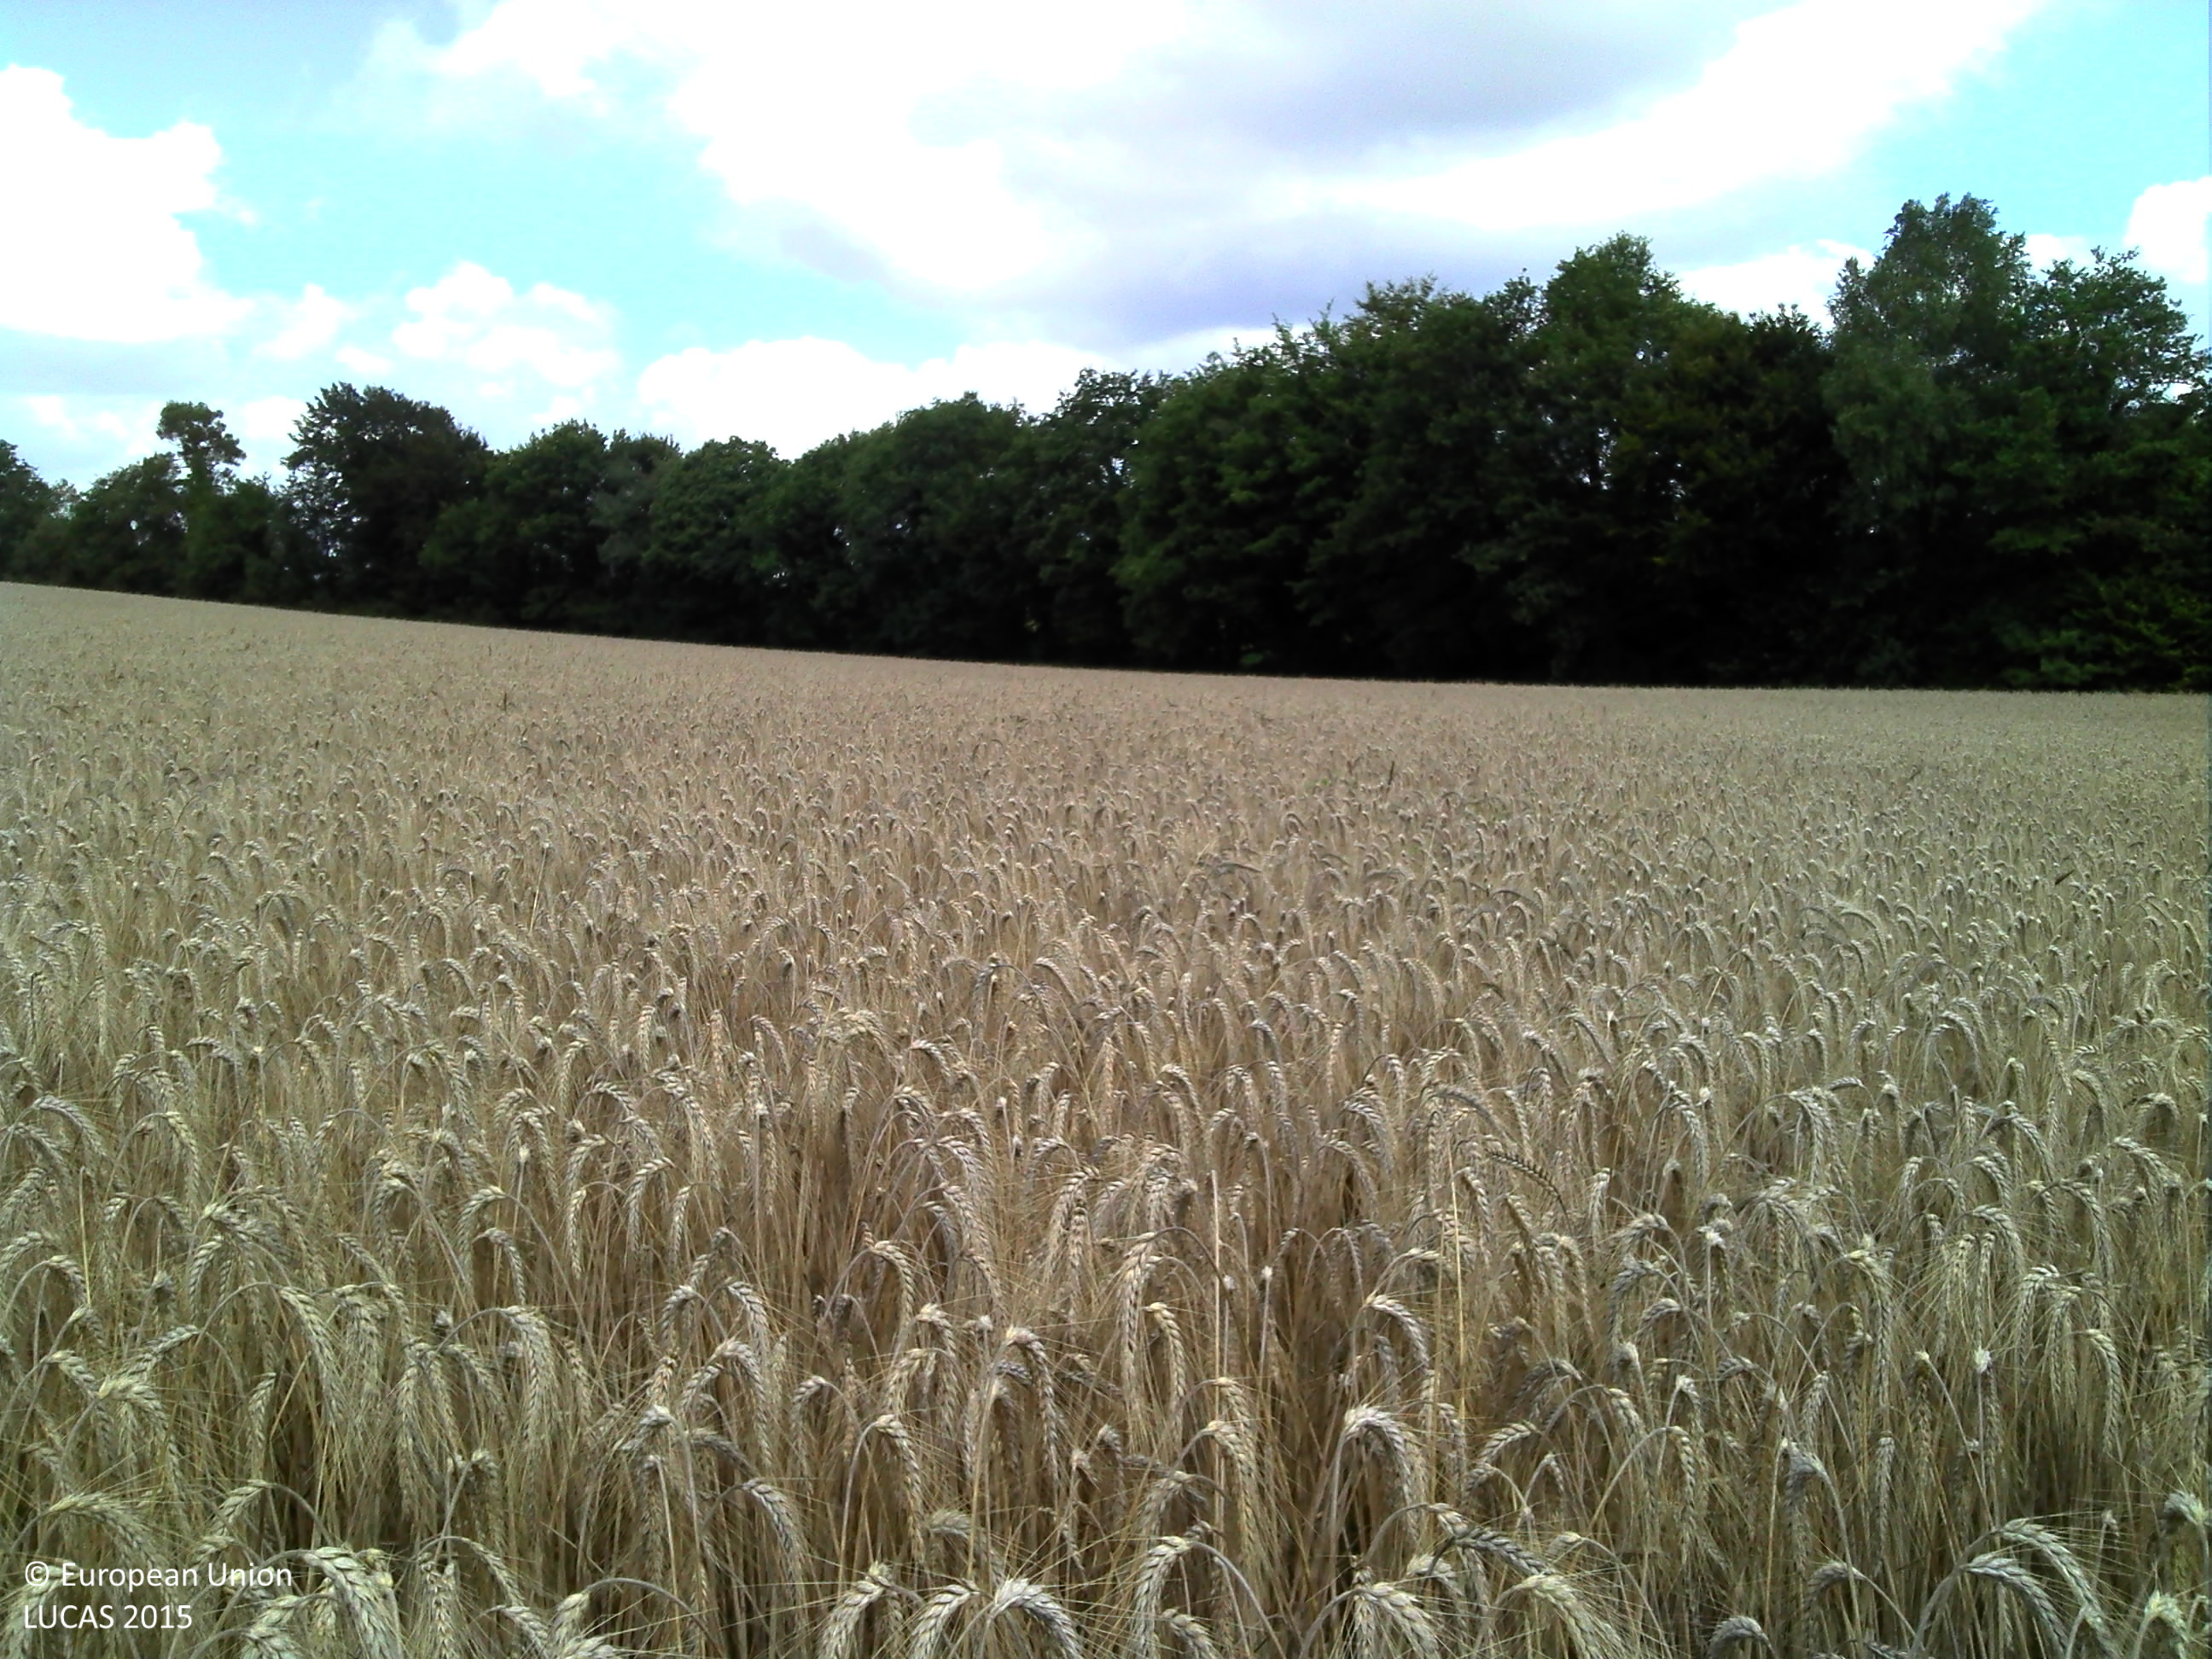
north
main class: Cropland
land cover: Common wheat
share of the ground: > 75 %
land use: Agriculture (excluding fallow land and kitchen gardens)
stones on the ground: < 10 %
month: July
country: FR
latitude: 47.7521
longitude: -2.9104
